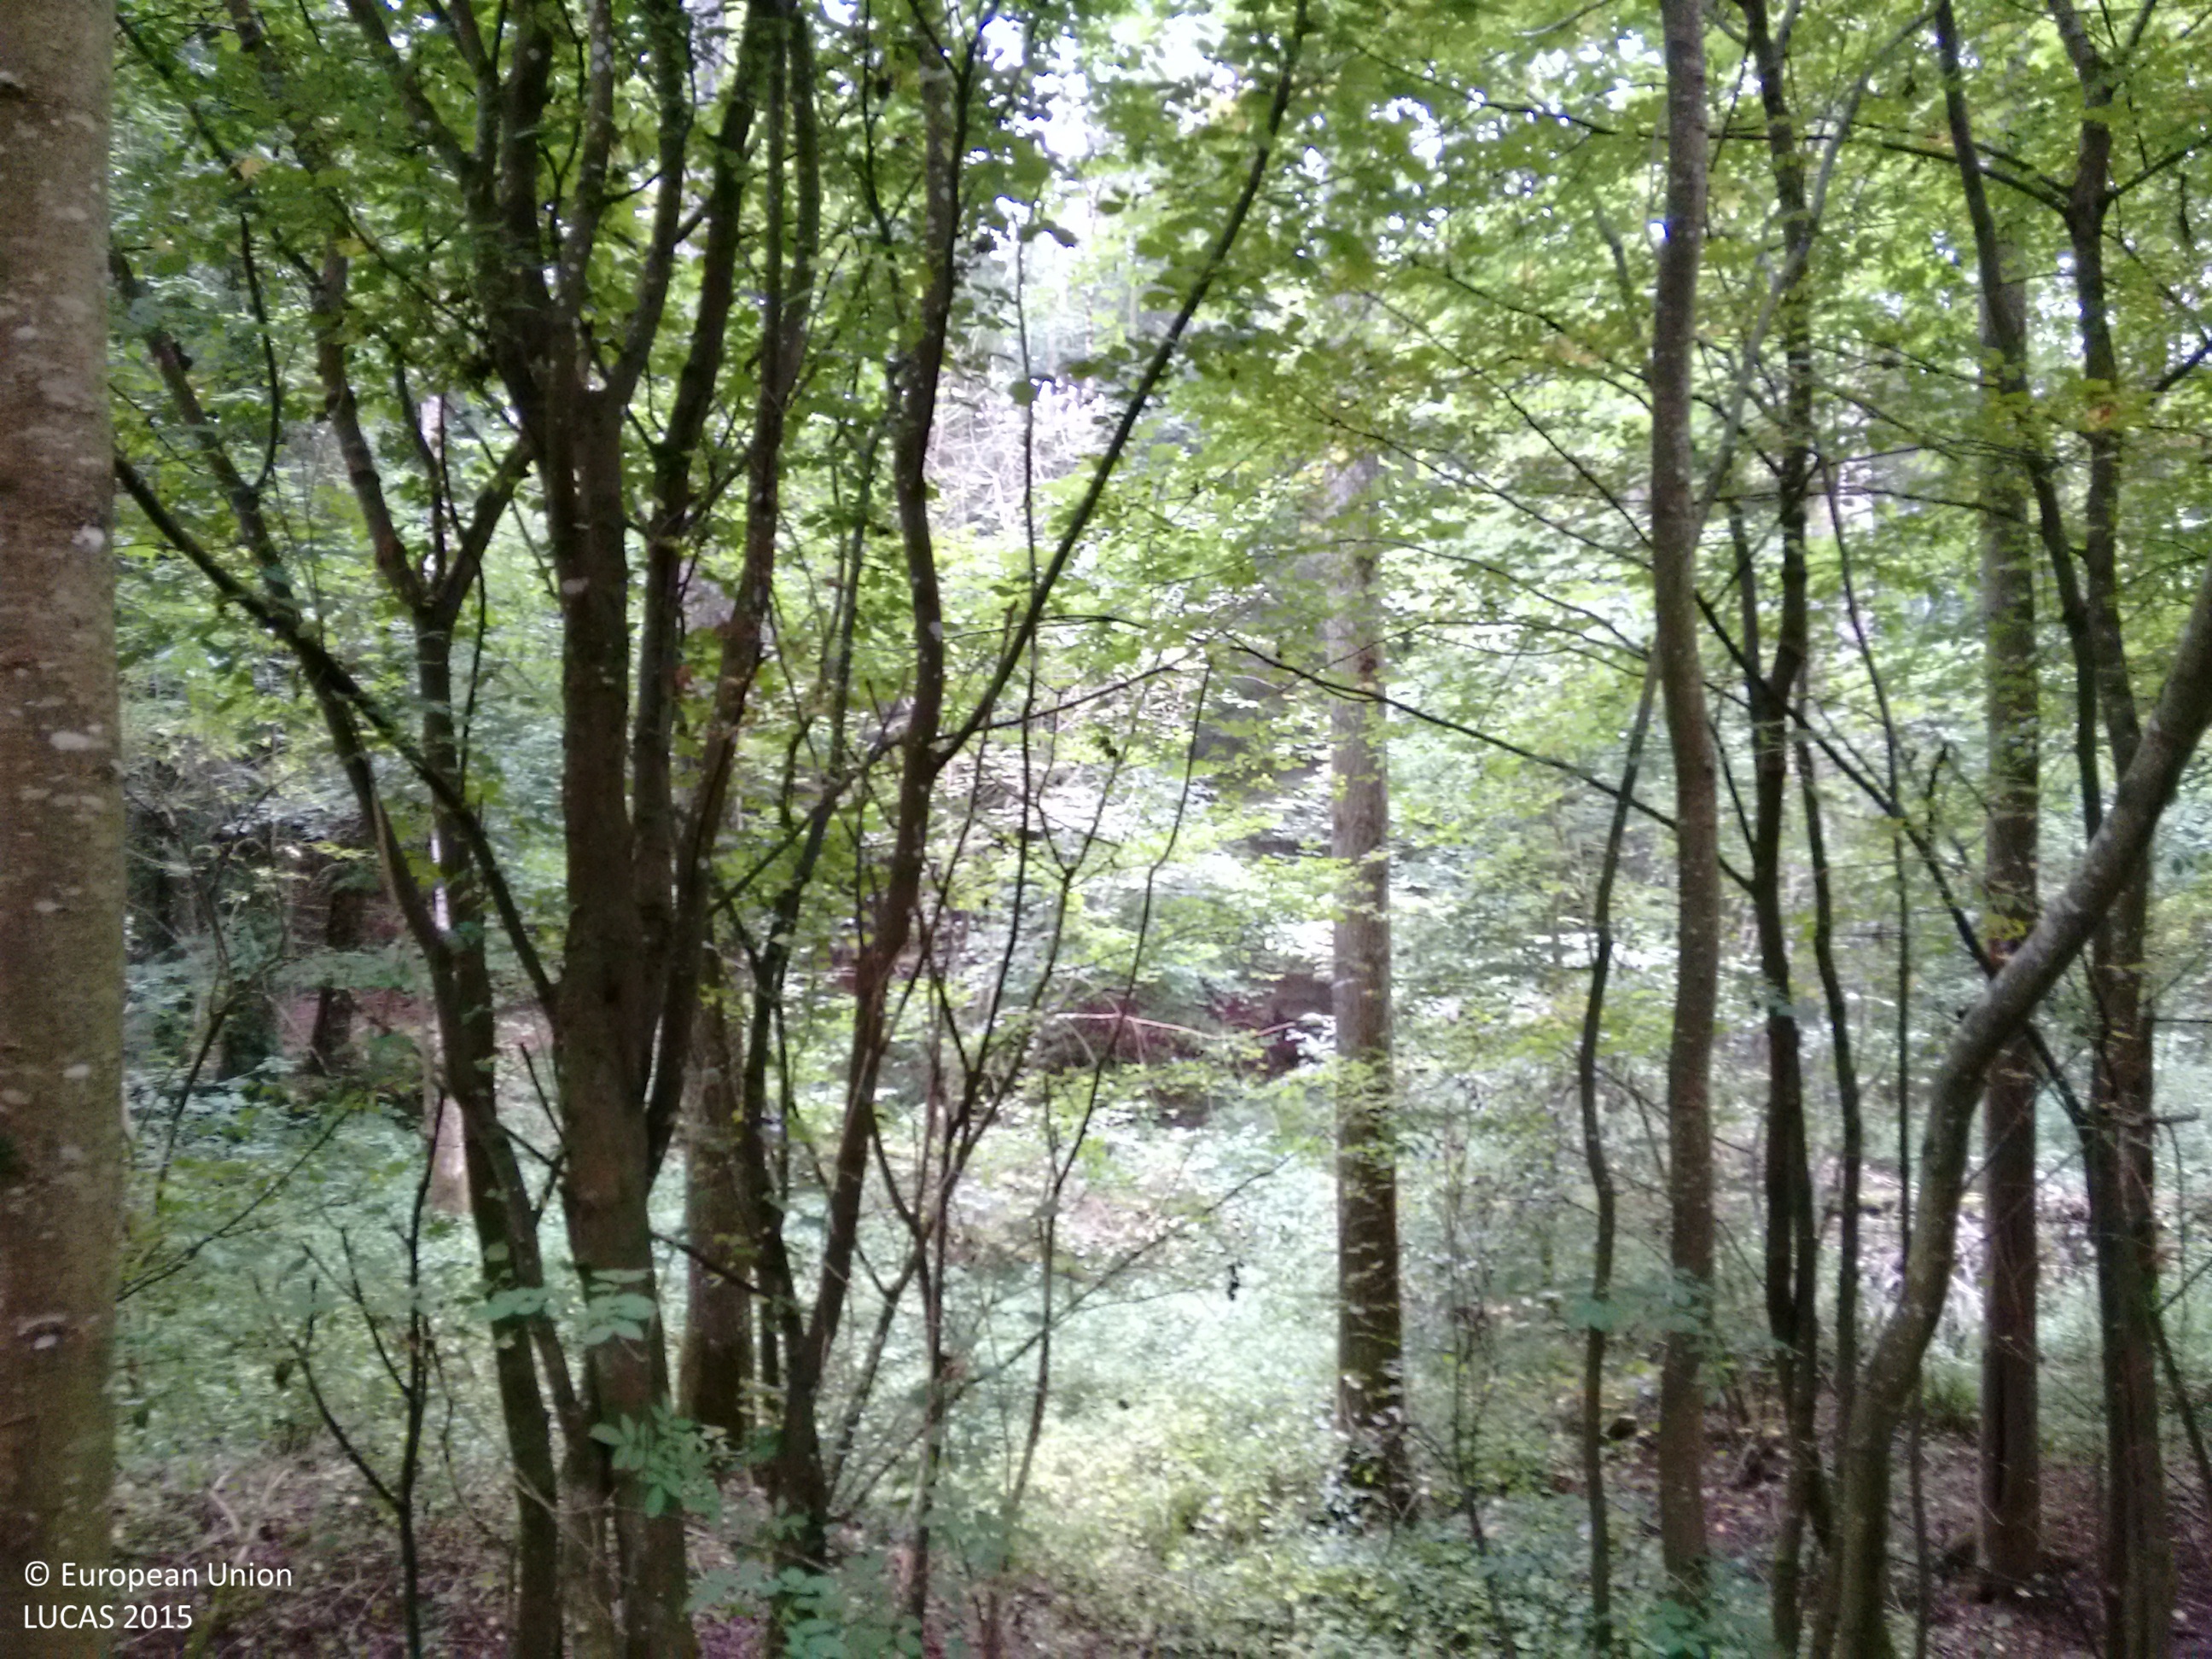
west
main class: Woodland
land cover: Broadleaved woodland
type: mesophytic deciduous forest
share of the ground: > 75 %
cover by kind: broadleaved forest trees 80 %, shrubs 20 %
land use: Semi-natural and natural areas not in use
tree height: > 5 m
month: September
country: GB
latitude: 52.0533
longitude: -3.2186
